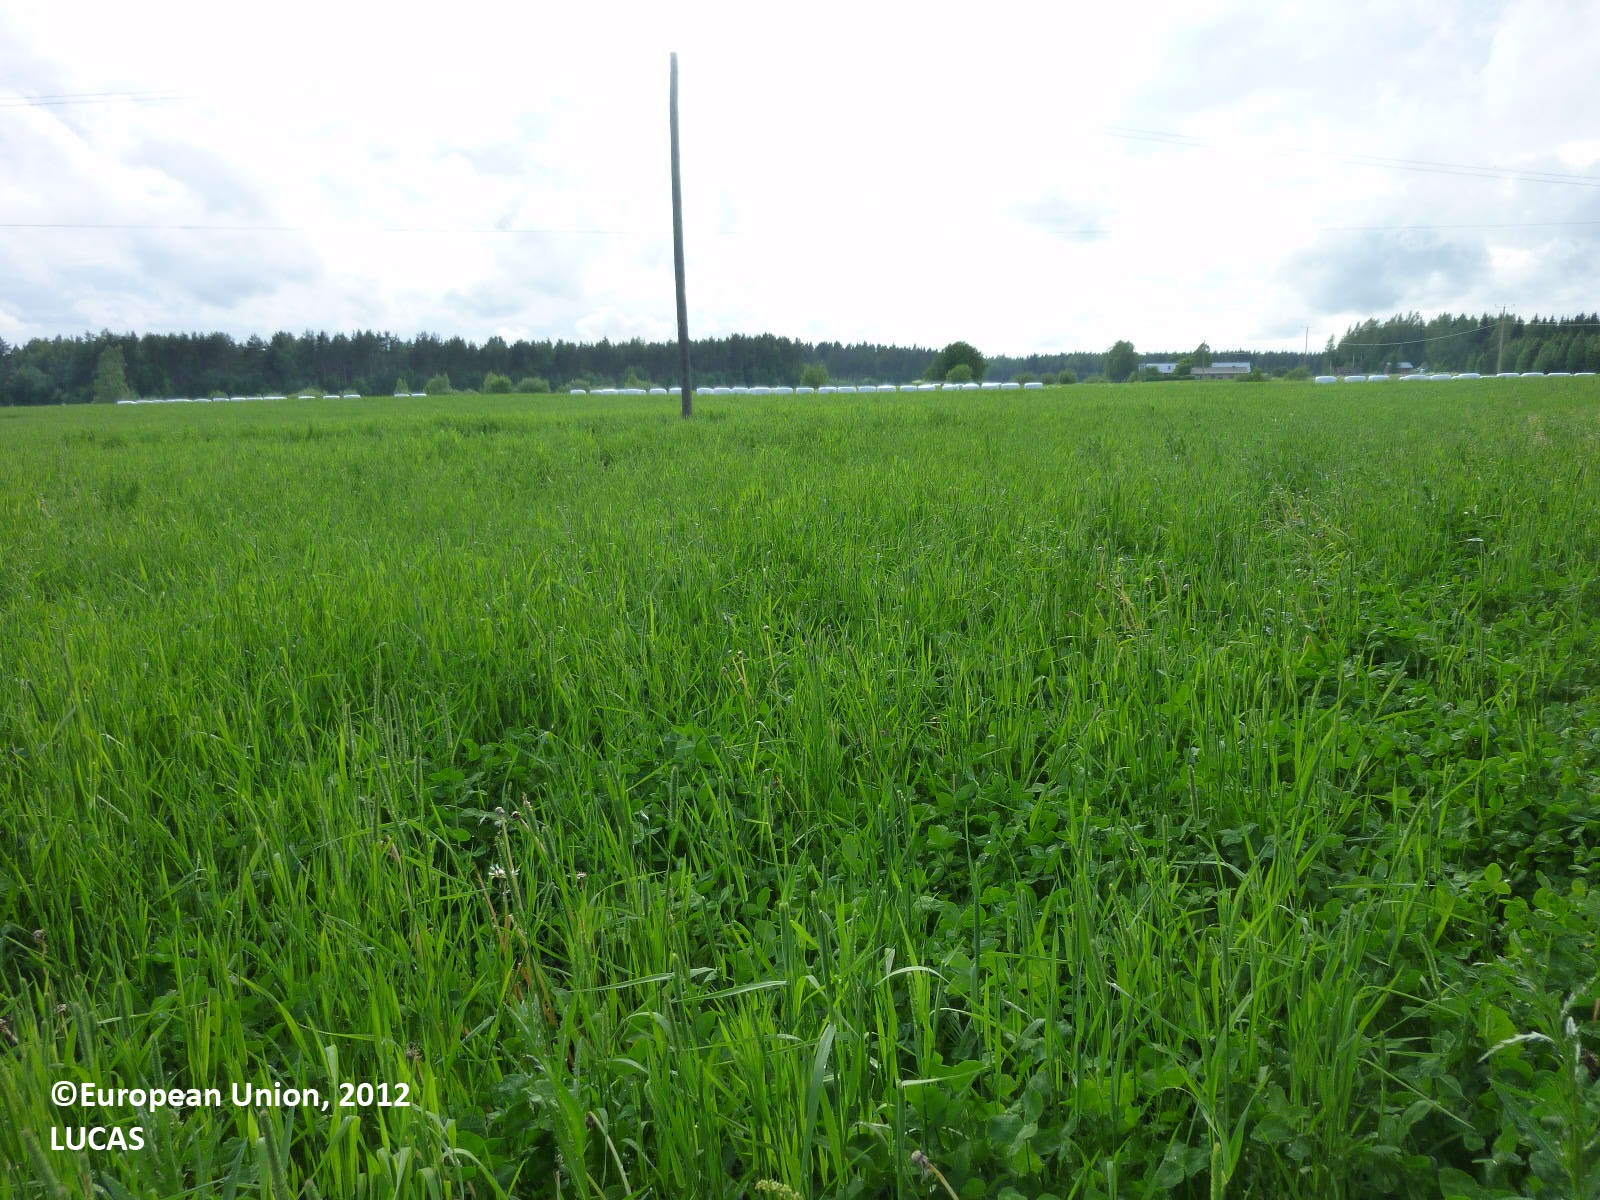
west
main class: Cropland
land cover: Temporary grasslands
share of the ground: 50 - 75 %
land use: Agriculture (excluding fallow land and kitchen gardens)
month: June
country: FI
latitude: 61.5968
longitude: 22.4815
